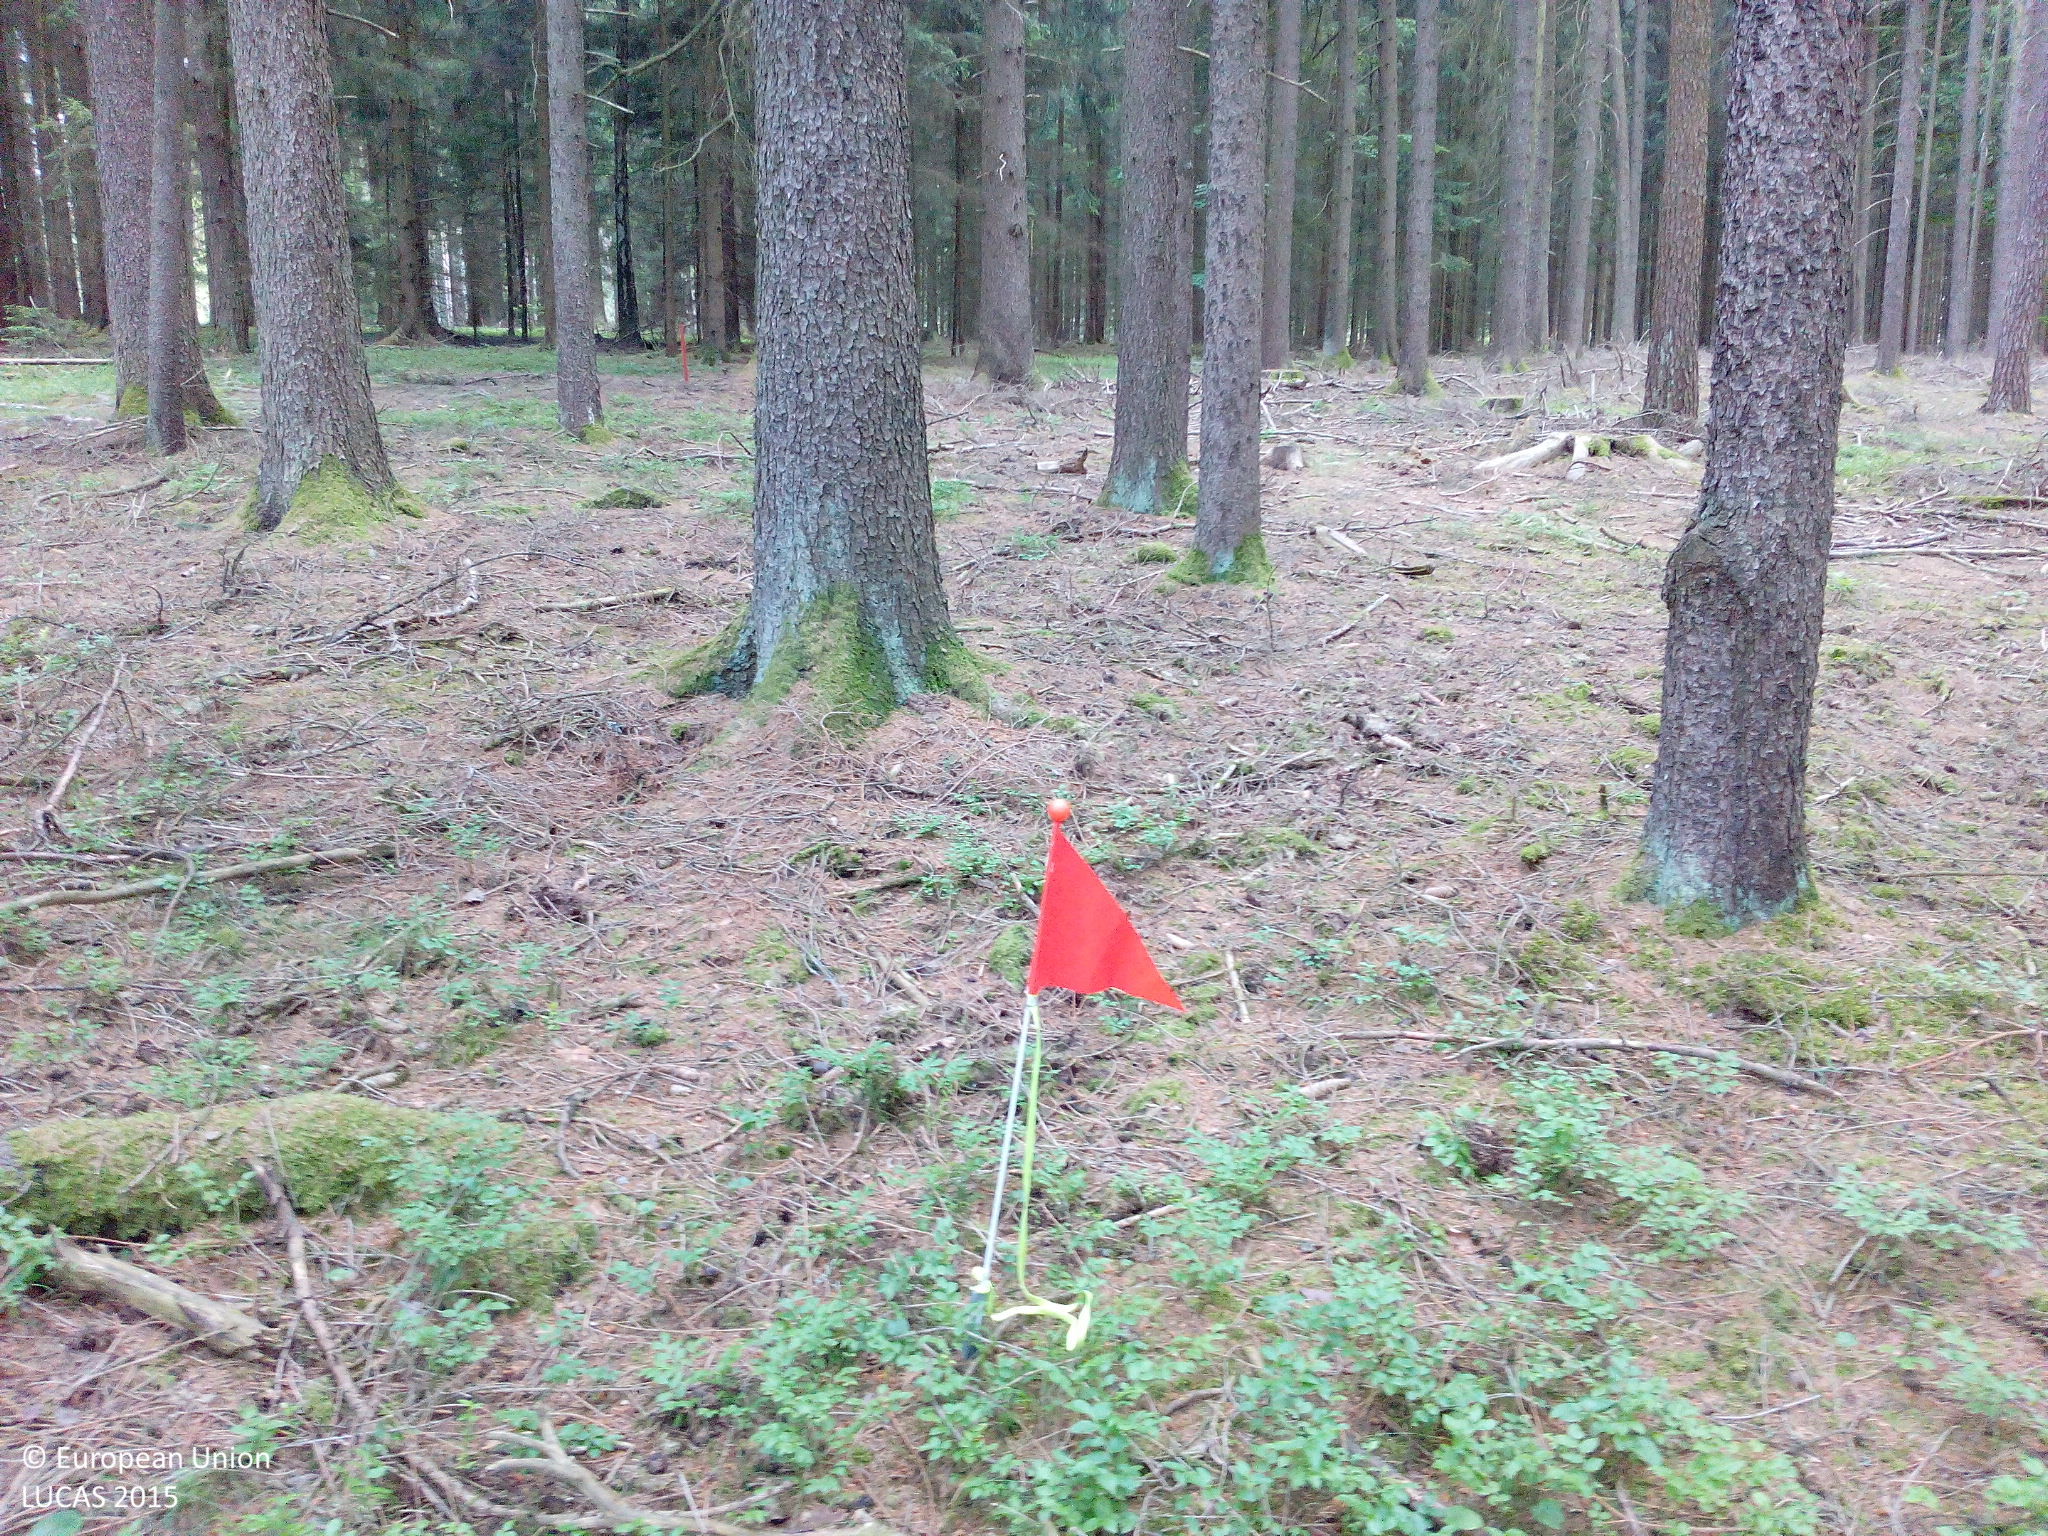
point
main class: Woodland
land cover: Spruce dominated coniferous woodland
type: hemiboreal forest and nemoral coniferous forest and mixed broadleaved-coniferous forest
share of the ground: 50 - 75 %
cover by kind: coniferous forest trees 70 %, herbaceous plants 10 %, lichens and mosses 10 %, unconsolidated bare surface 10 %
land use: Forestry
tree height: > 5 m
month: June
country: DE
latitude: 48.9267
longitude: 11.9238
